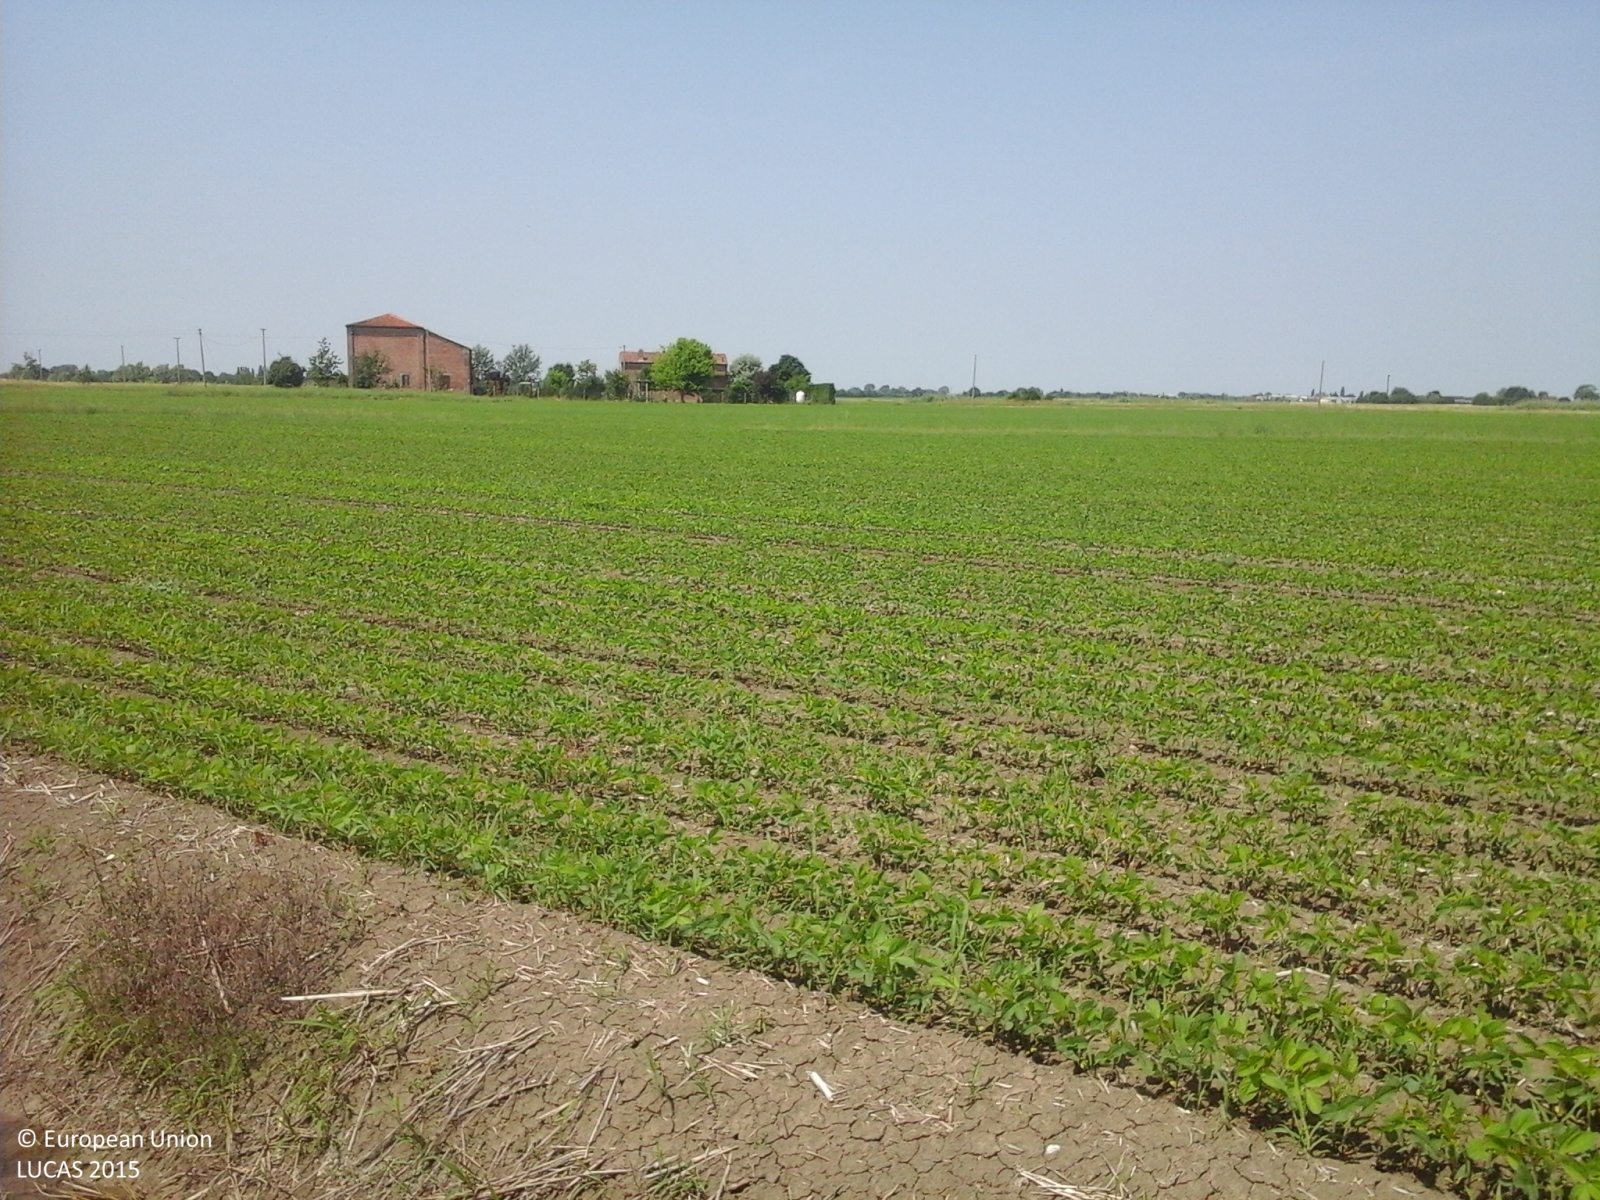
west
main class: Cropland
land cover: Soya
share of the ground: 10 - 25 %
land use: Agriculture (excluding fallow land and kitchen gardens)
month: May
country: IT
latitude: 44.7695
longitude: 11.7024
